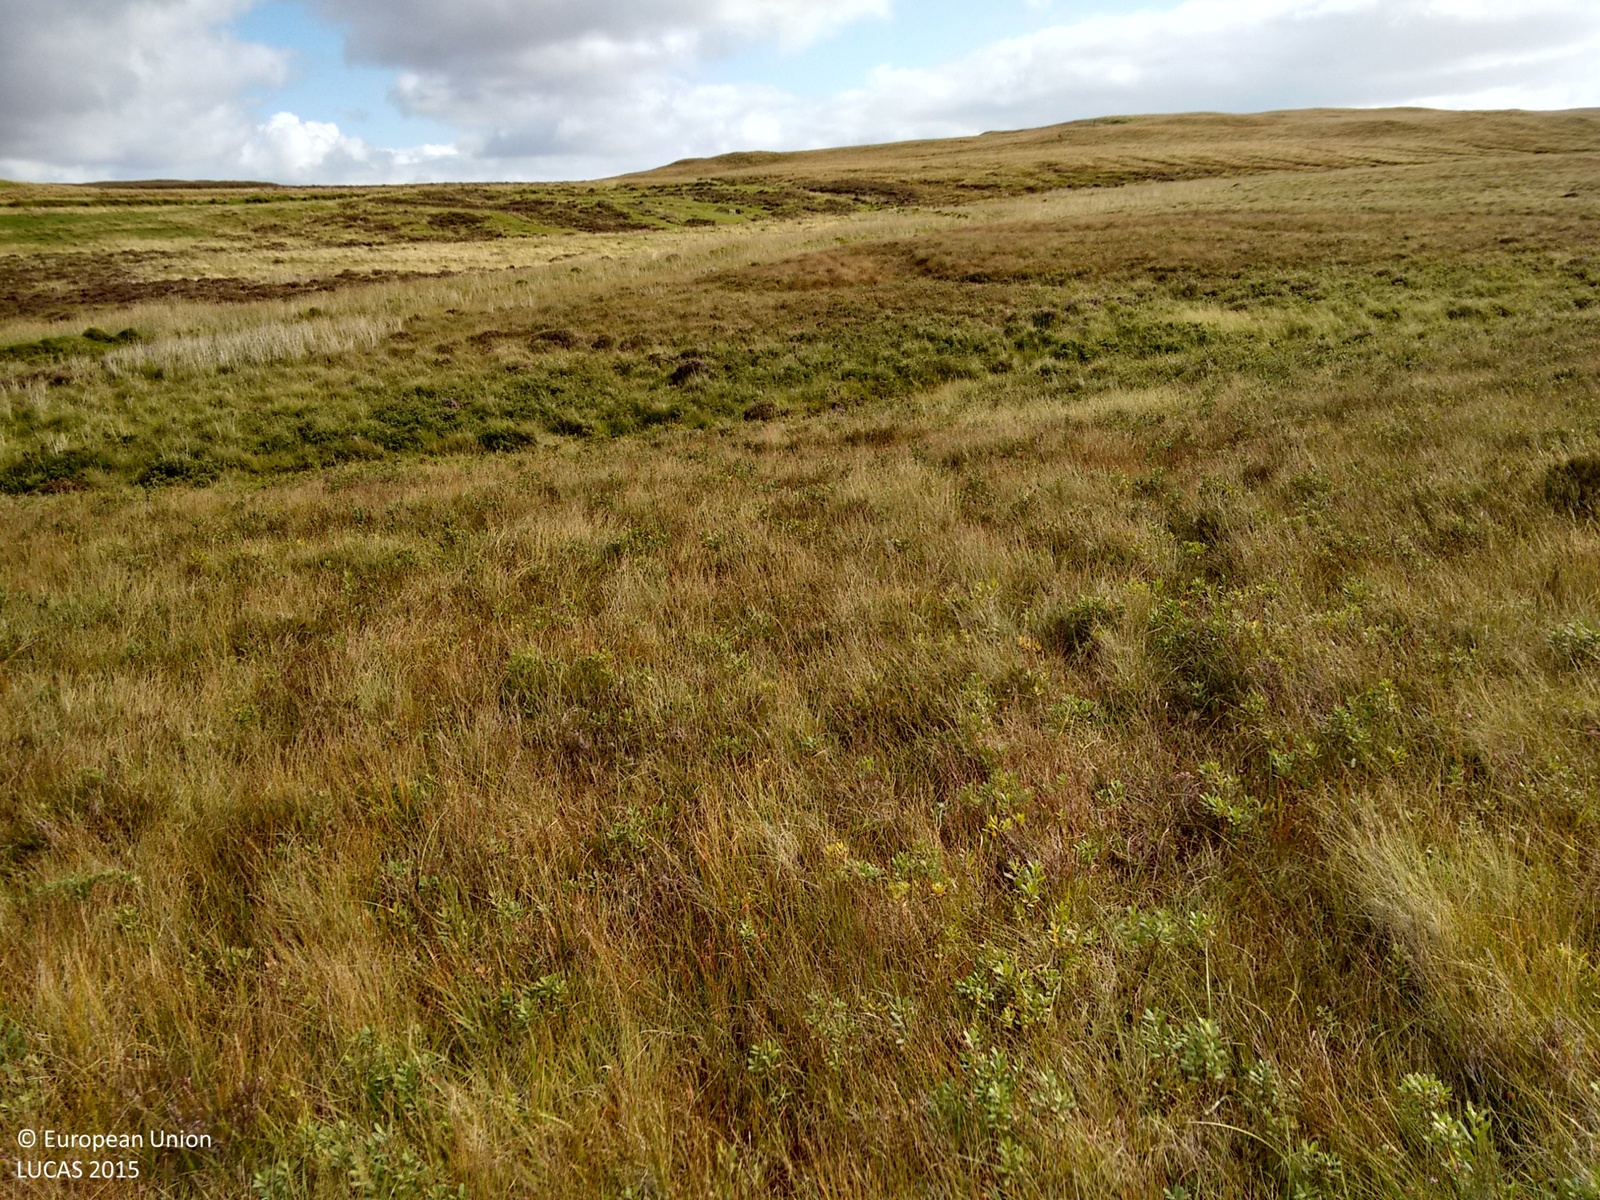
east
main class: Shrubland
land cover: Shrubland without tree cover
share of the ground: > 75 %
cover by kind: shrubs 75 %, herbaceous plants 25 %
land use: Agriculture (excluding fallow land and kitchen gardens)
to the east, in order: Shrubland without tree cover; Rivers and streams; Shrubland without tree cover; Rivers and streams; Shrubland without tree cover; Grassland without tree/shrub cover; Shrubland without tree cover; Rivers and streams; Shrubland without tree cover; Rivers and streams; Shrubland without tree cover
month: September
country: GB
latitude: 57.4180
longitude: -6.5788
